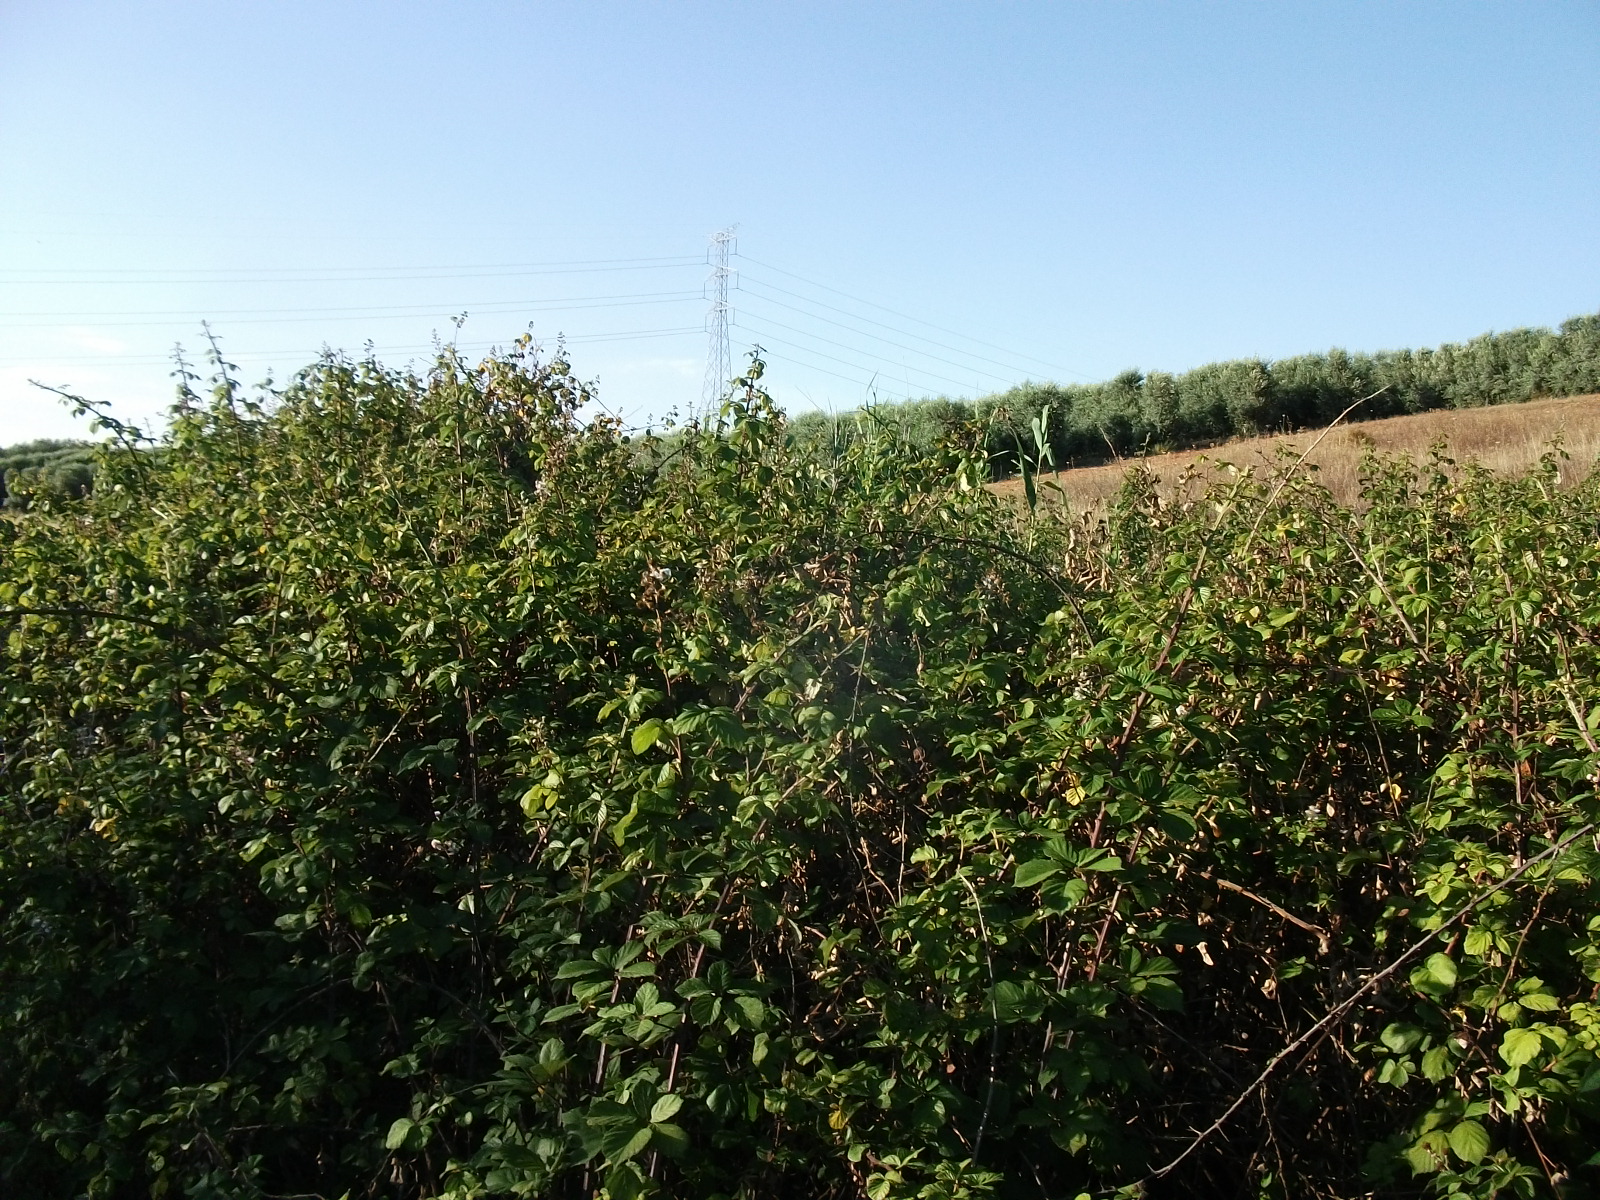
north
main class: Grassland
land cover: Spontaneously vegetated surfaces
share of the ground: > 75 %
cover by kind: herbaceous plants 100 %
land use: Fallow land
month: June
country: ES
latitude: 37.4161
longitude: -6.6335
